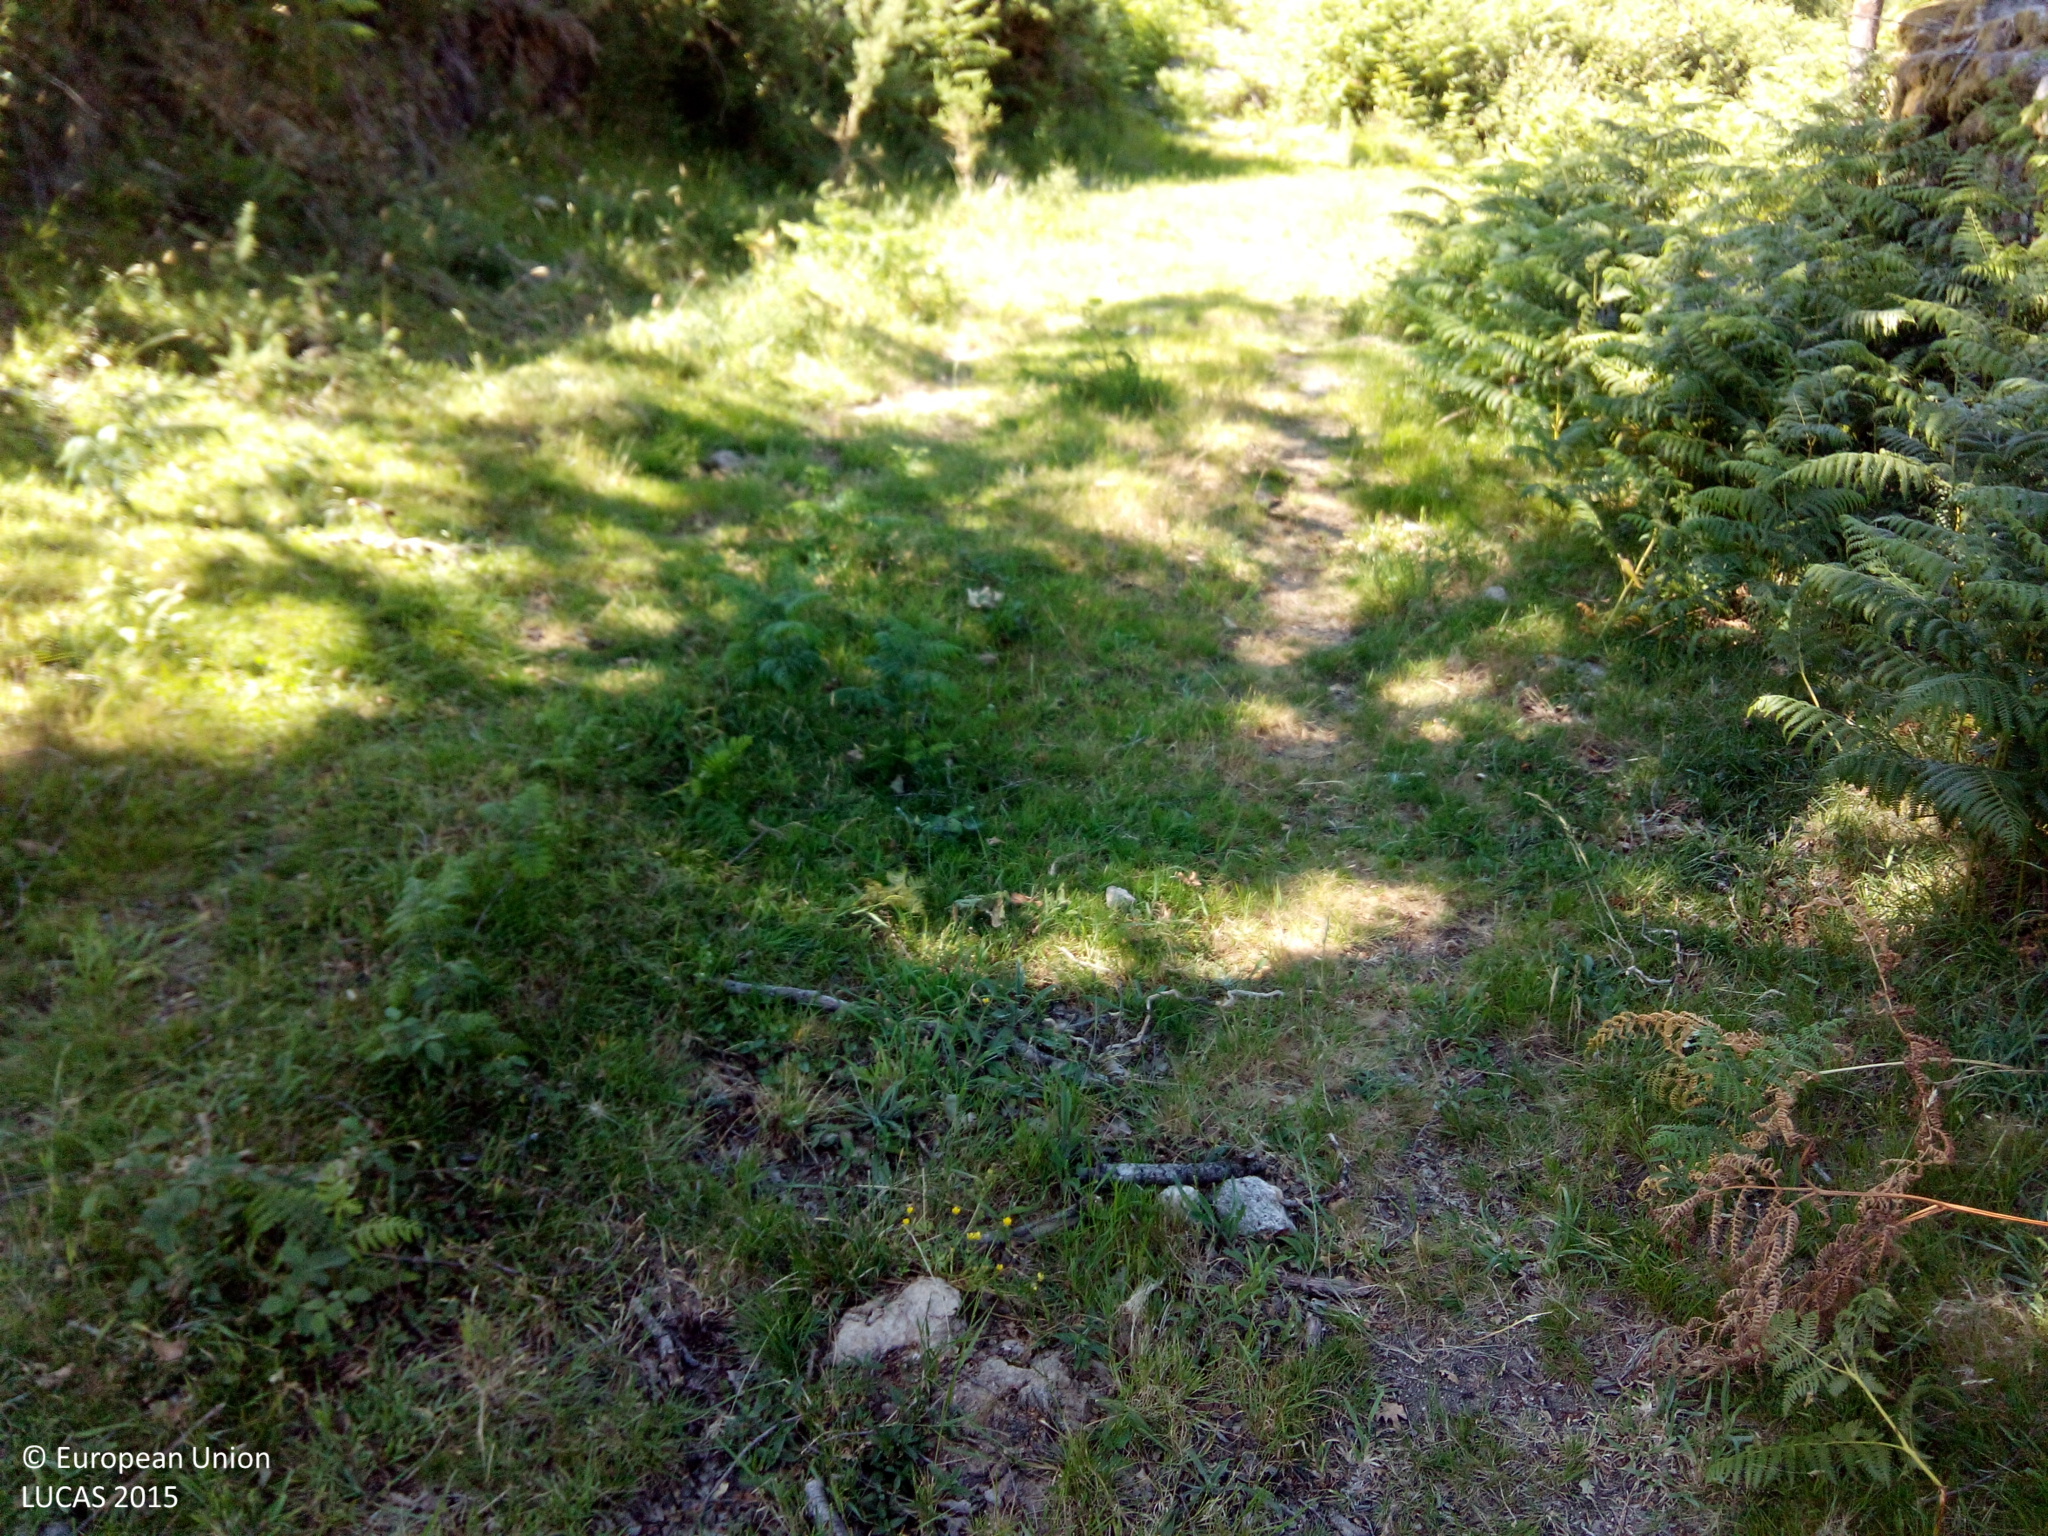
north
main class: Shrubland
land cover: Shrubland without tree cover
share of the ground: > 75 %
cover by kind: shrubs 100 %
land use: Abandoned areas
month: June
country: ES
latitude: 42.3571
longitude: -8.3891
